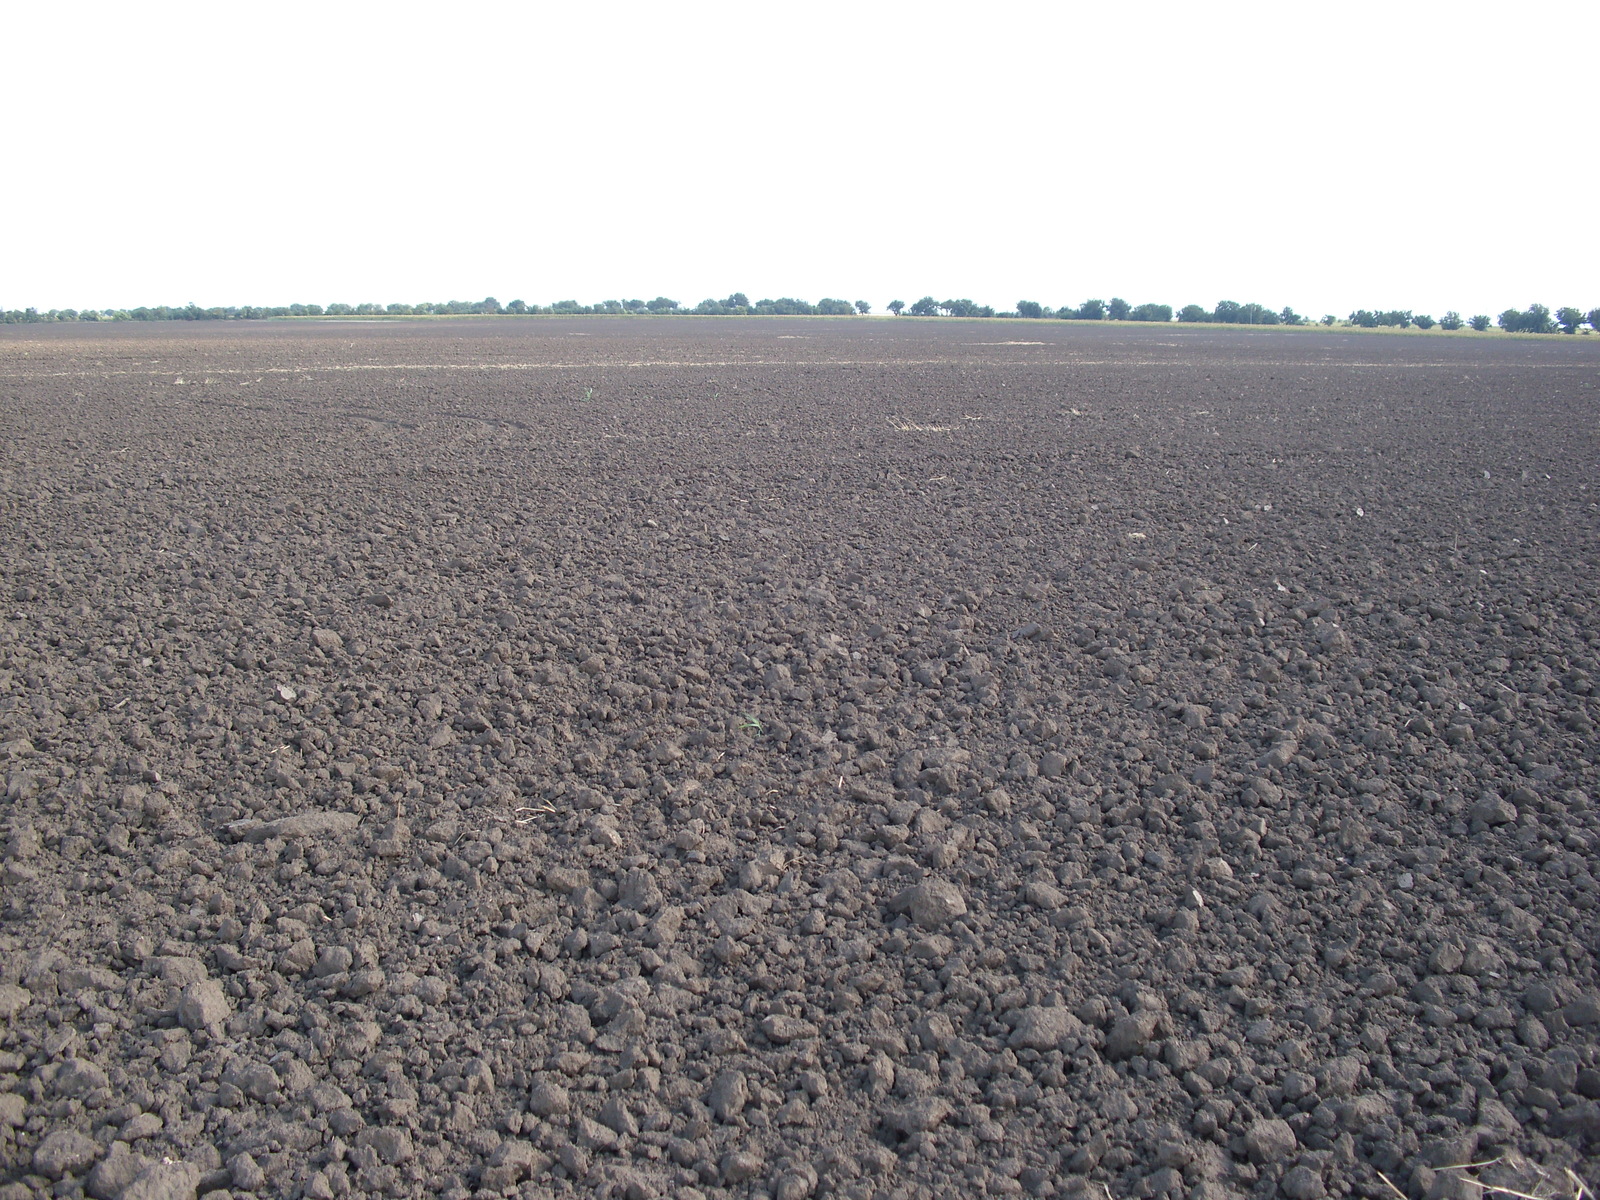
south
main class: Cropland
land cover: Common wheat
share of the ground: < 10 %
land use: Agriculture (excluding fallow land and kitchen gardens)
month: August
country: BG
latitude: 43.7466
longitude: 23.2938
